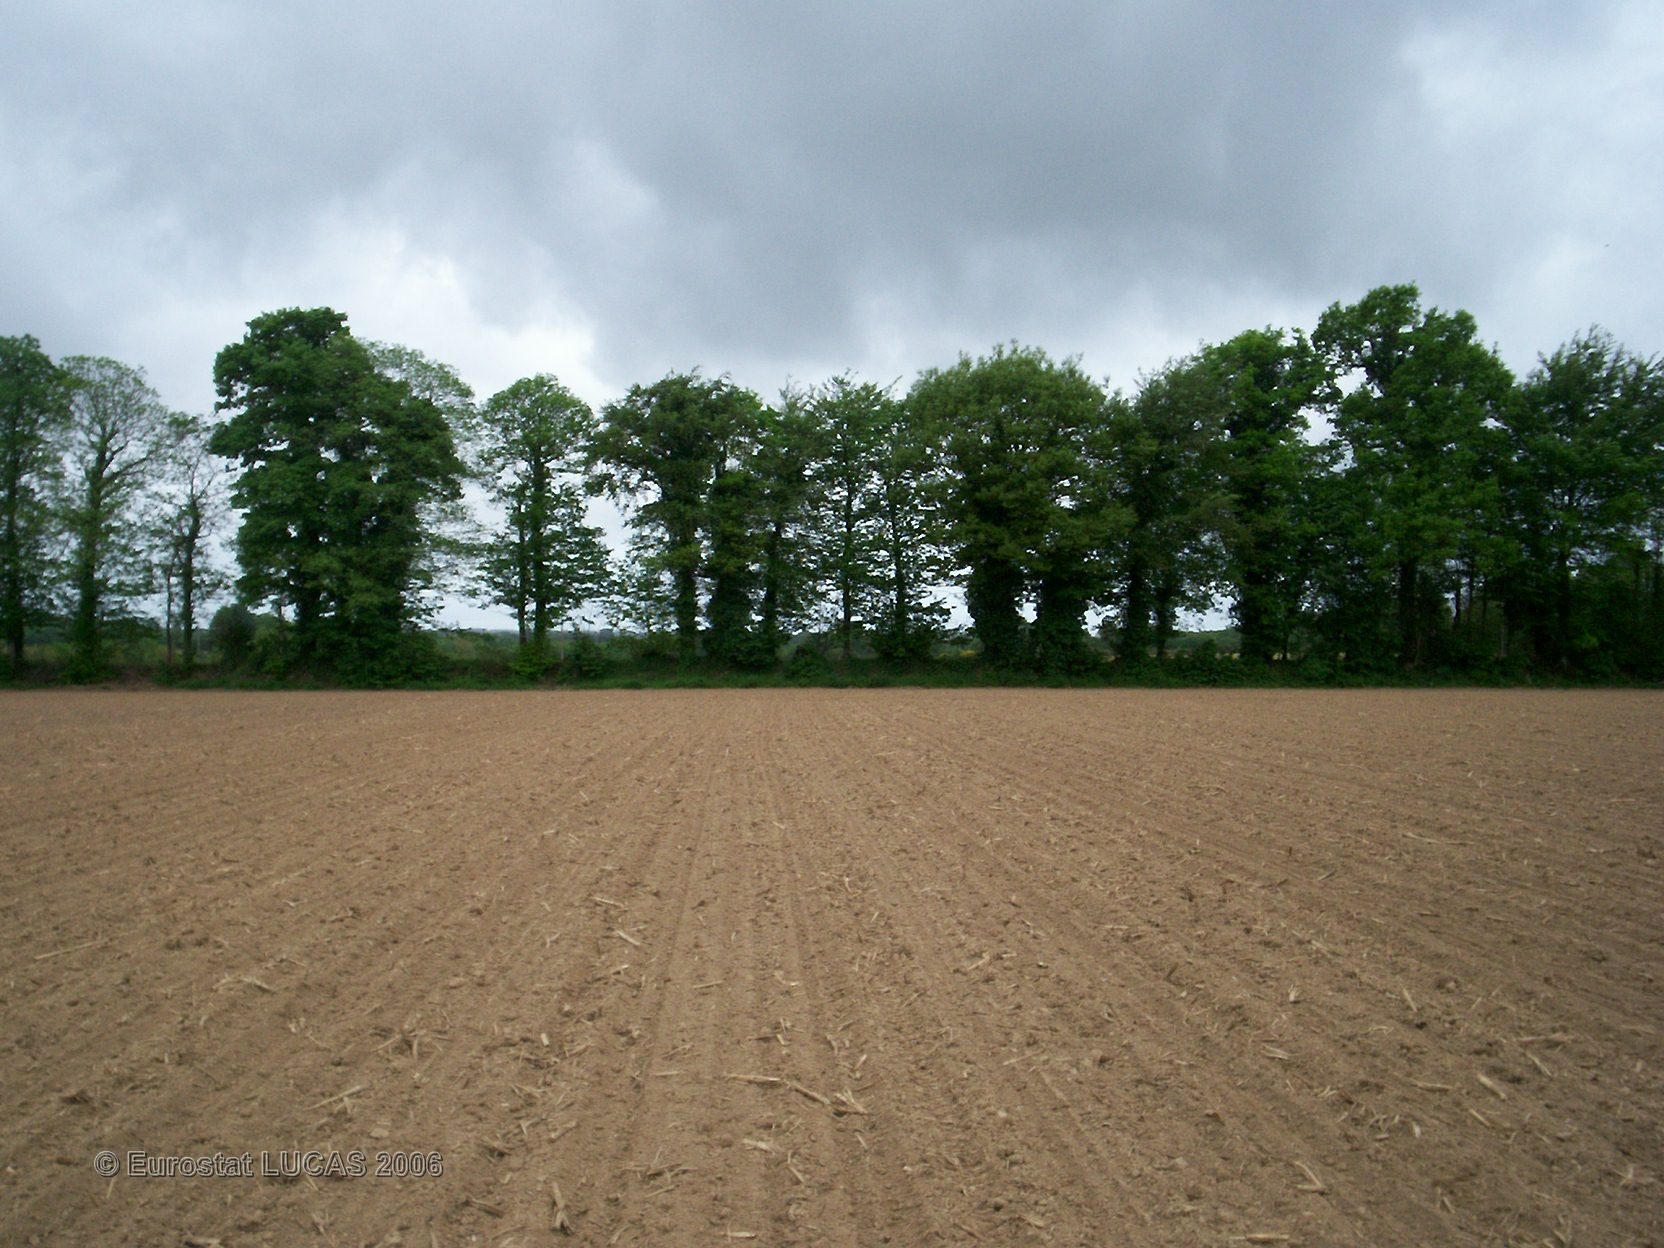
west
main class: Cropland
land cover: Maize
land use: Agriculture (excluding fallow land and kitchen gardens)
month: May
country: FR
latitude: 47.9237
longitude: -2.8455
